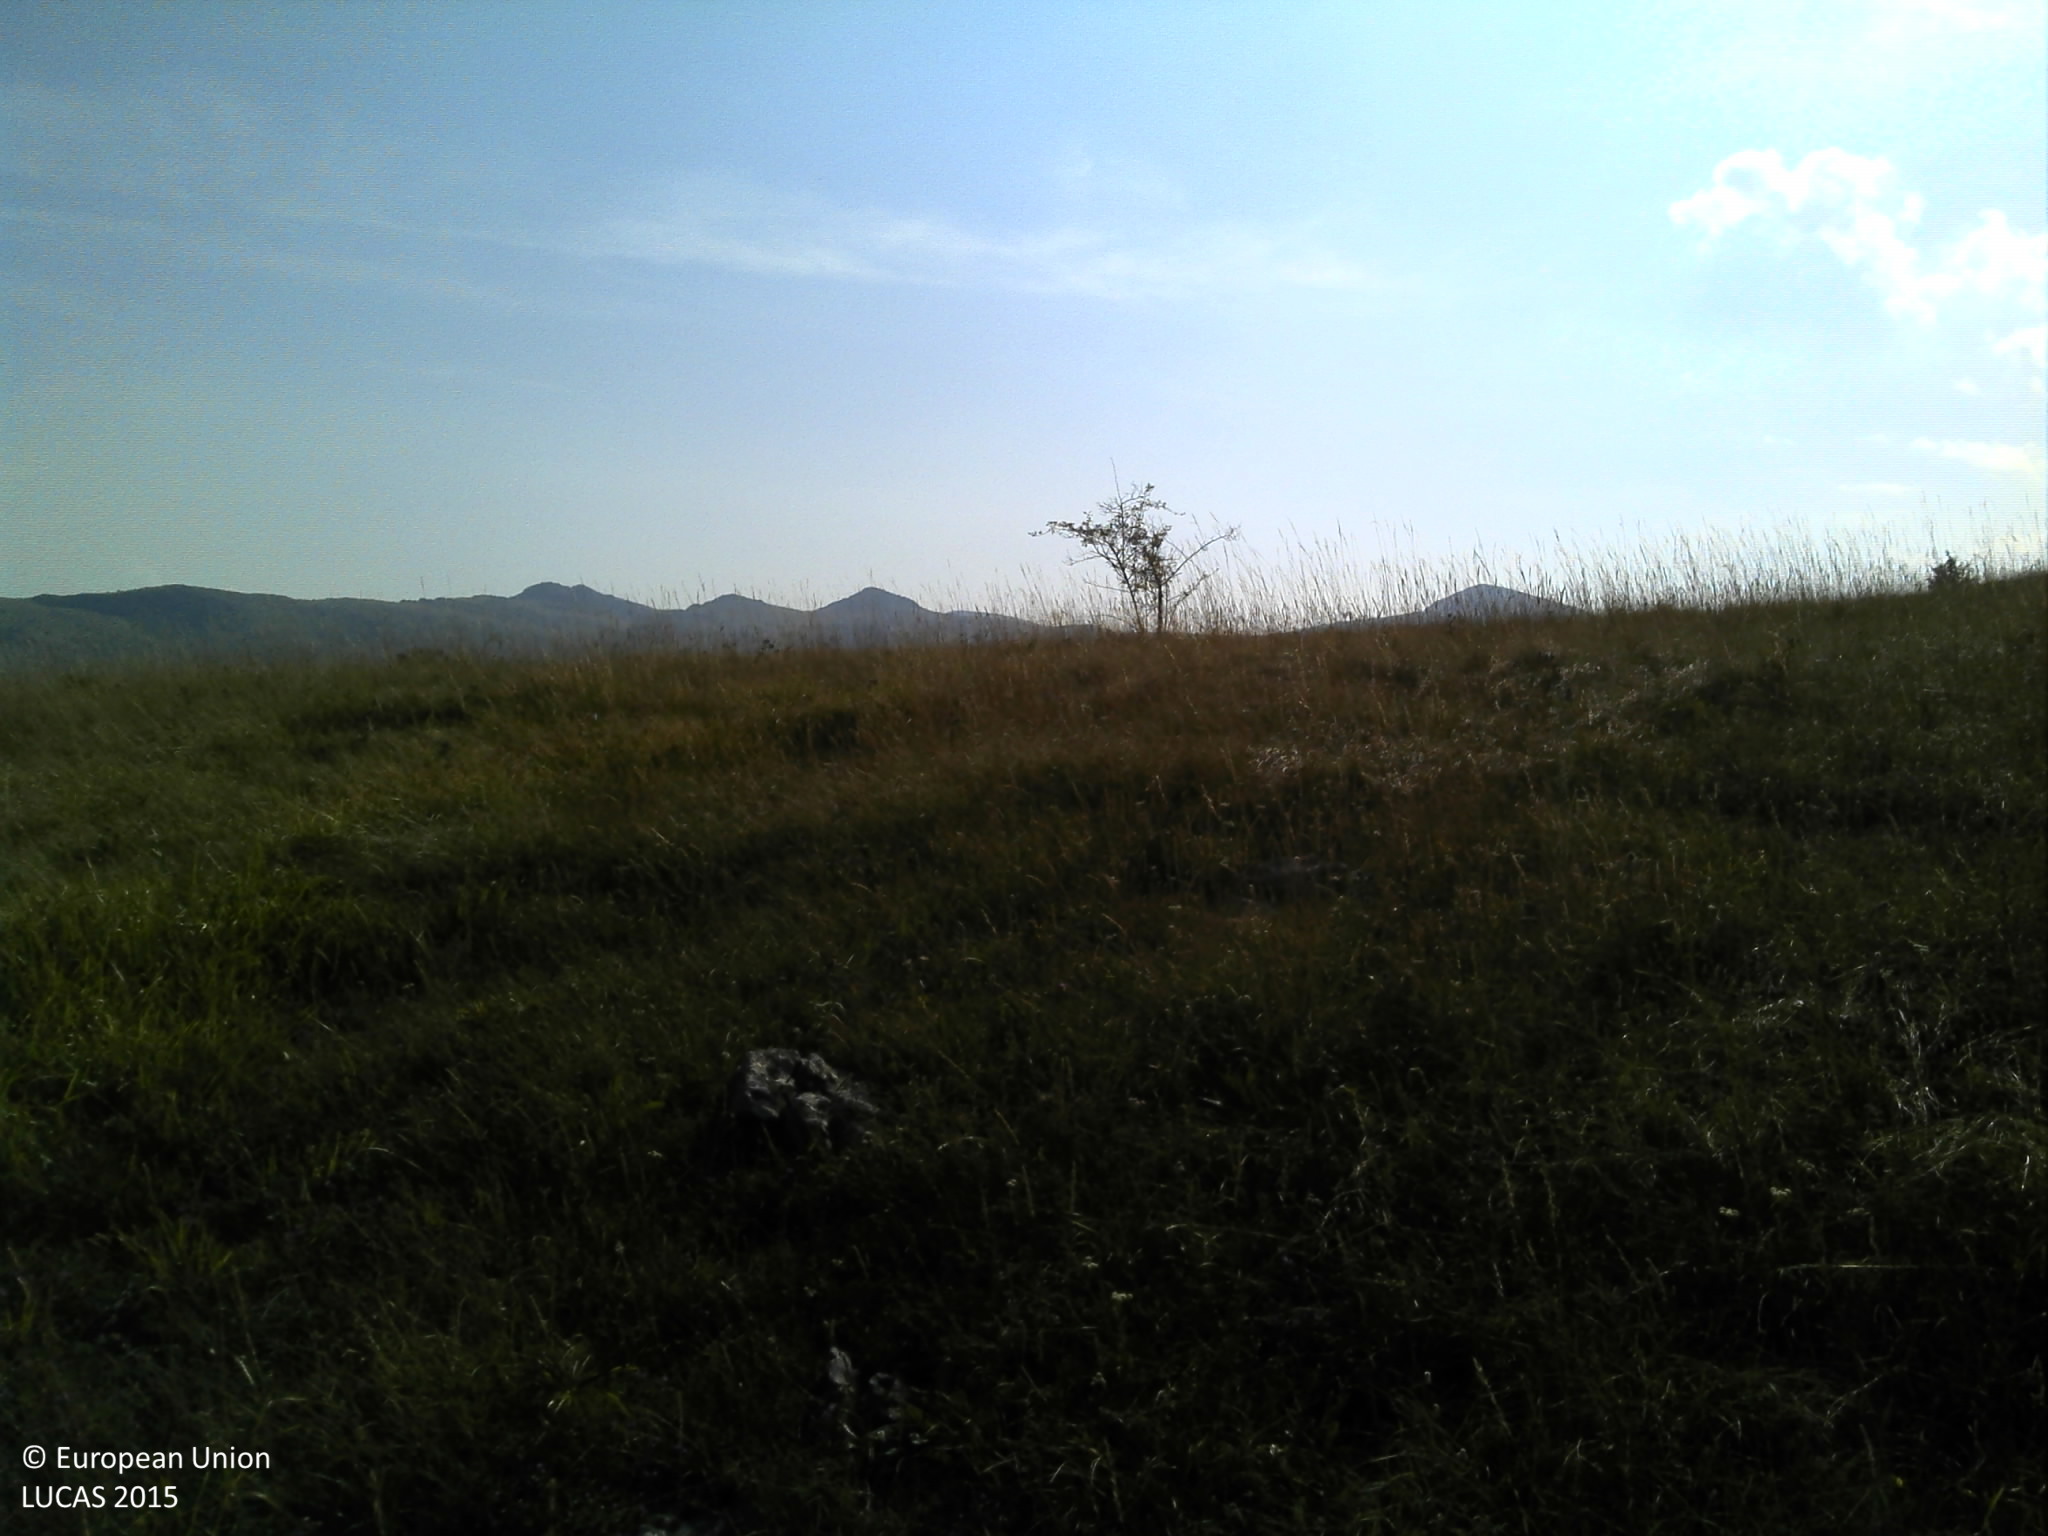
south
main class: Grassland
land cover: Grassland with sparse tree/shrub cover
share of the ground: > 75 %
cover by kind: herbaceous plants 85 %, broadleaved forest trees 5 %, shrubs 5 %, consolidated bare surface 5 %
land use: Semi-natural and natural areas not in use
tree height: < 5 m
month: September
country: HR
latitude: 44.3439
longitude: 15.9263
